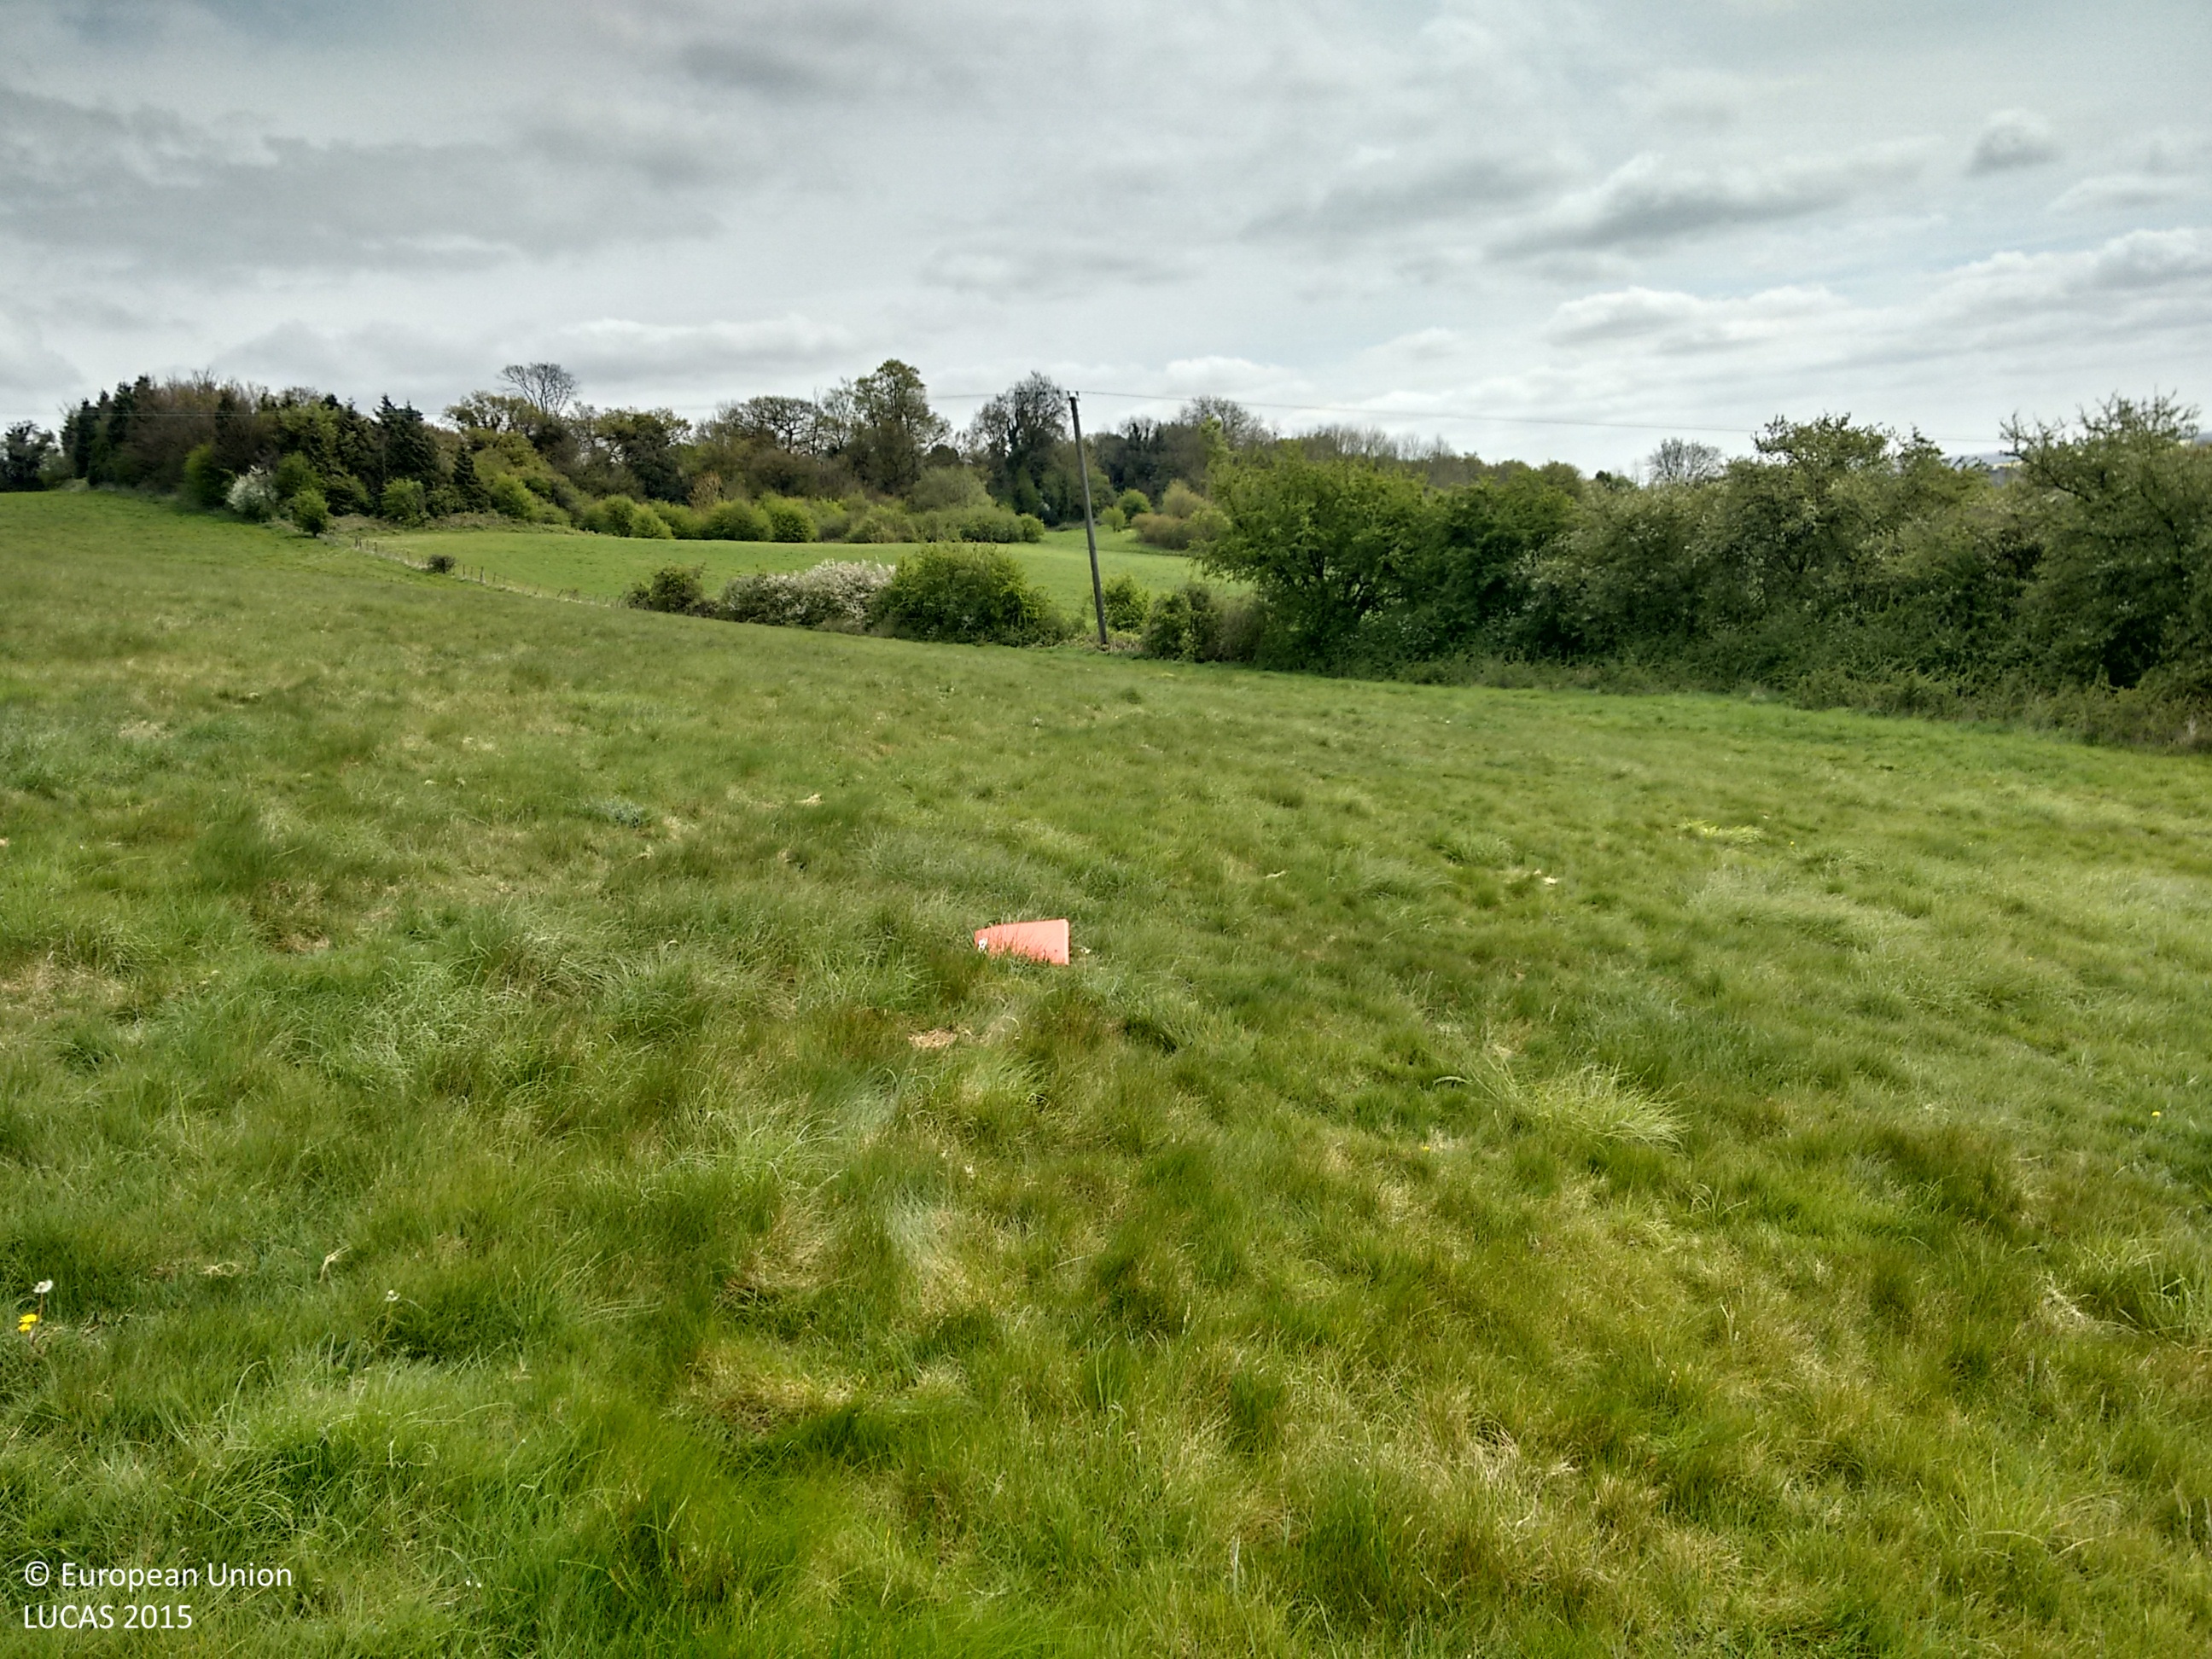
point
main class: Grassland
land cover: Grassland without tree/shrub cover
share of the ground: > 75 %
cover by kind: herbaceous plants 100 %
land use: Semi-natural and natural areas not in use
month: May
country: GB
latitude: 51.2518
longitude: 0.7040
